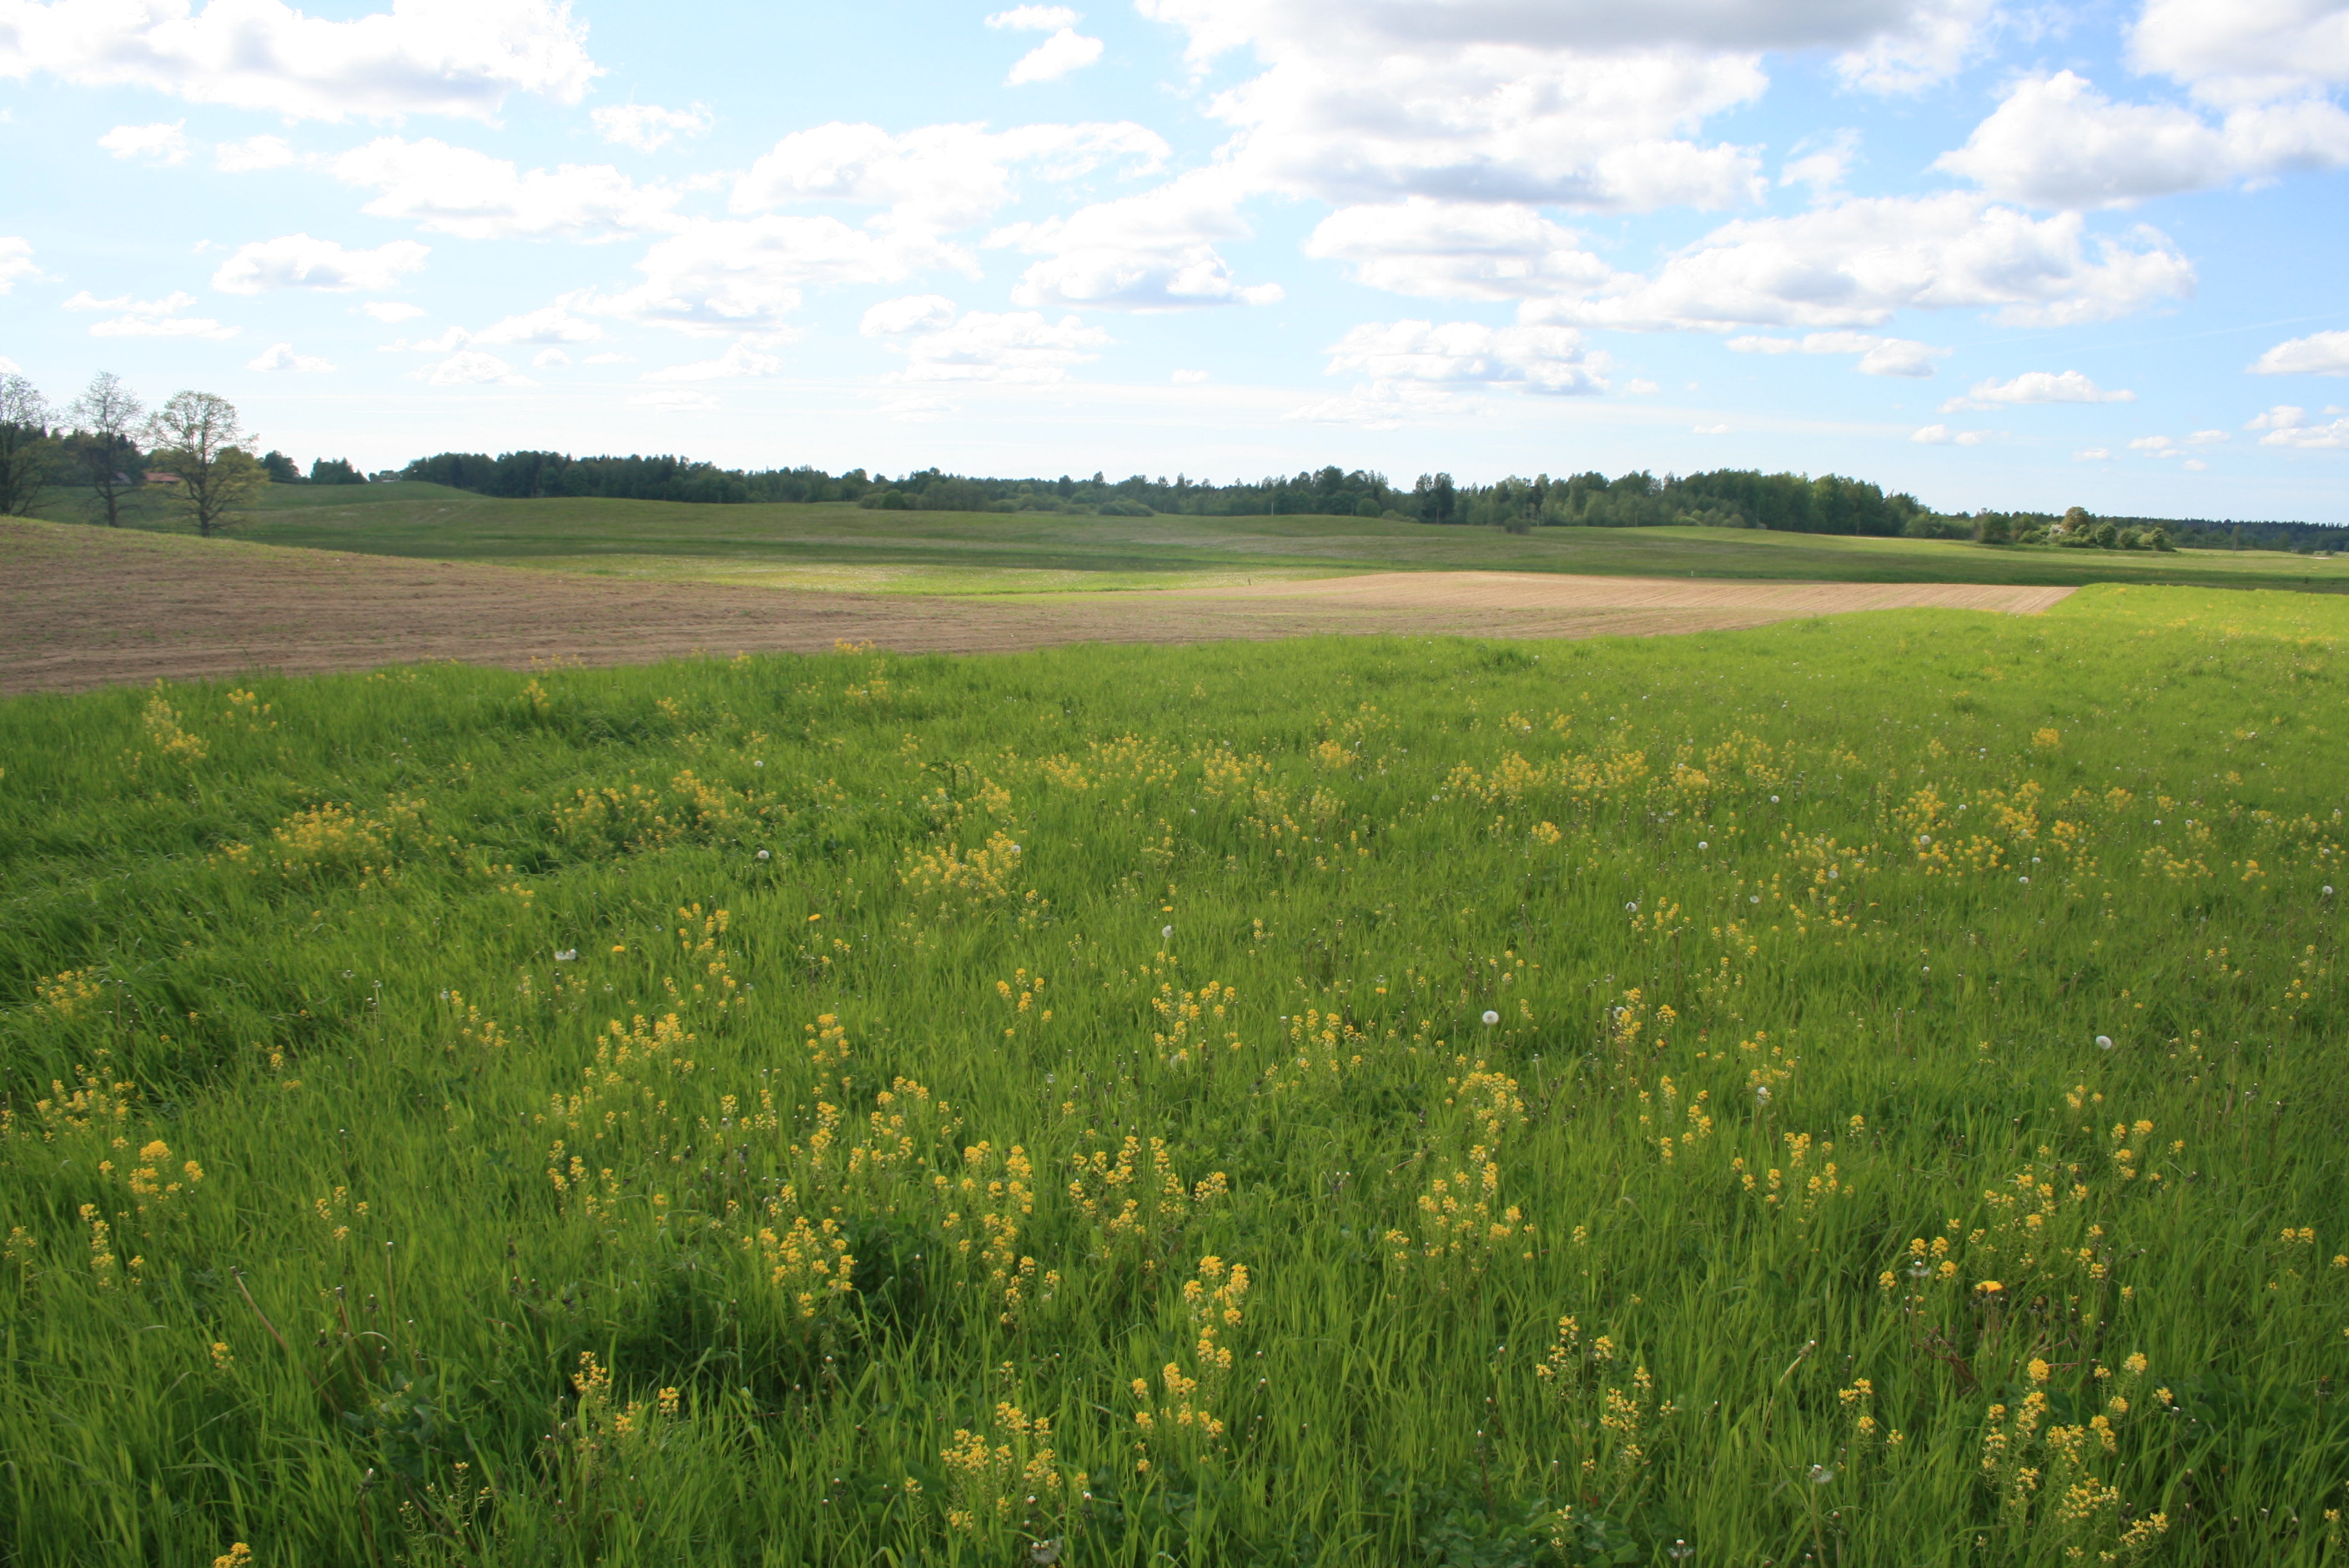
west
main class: Cropland
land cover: Other leguminous and mixtures for fodder
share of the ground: > 75 %
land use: Agriculture (excluding fallow land and kitchen gardens)
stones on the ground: < 10 %
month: May
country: LT
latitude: 55.9838
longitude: 22.0247
